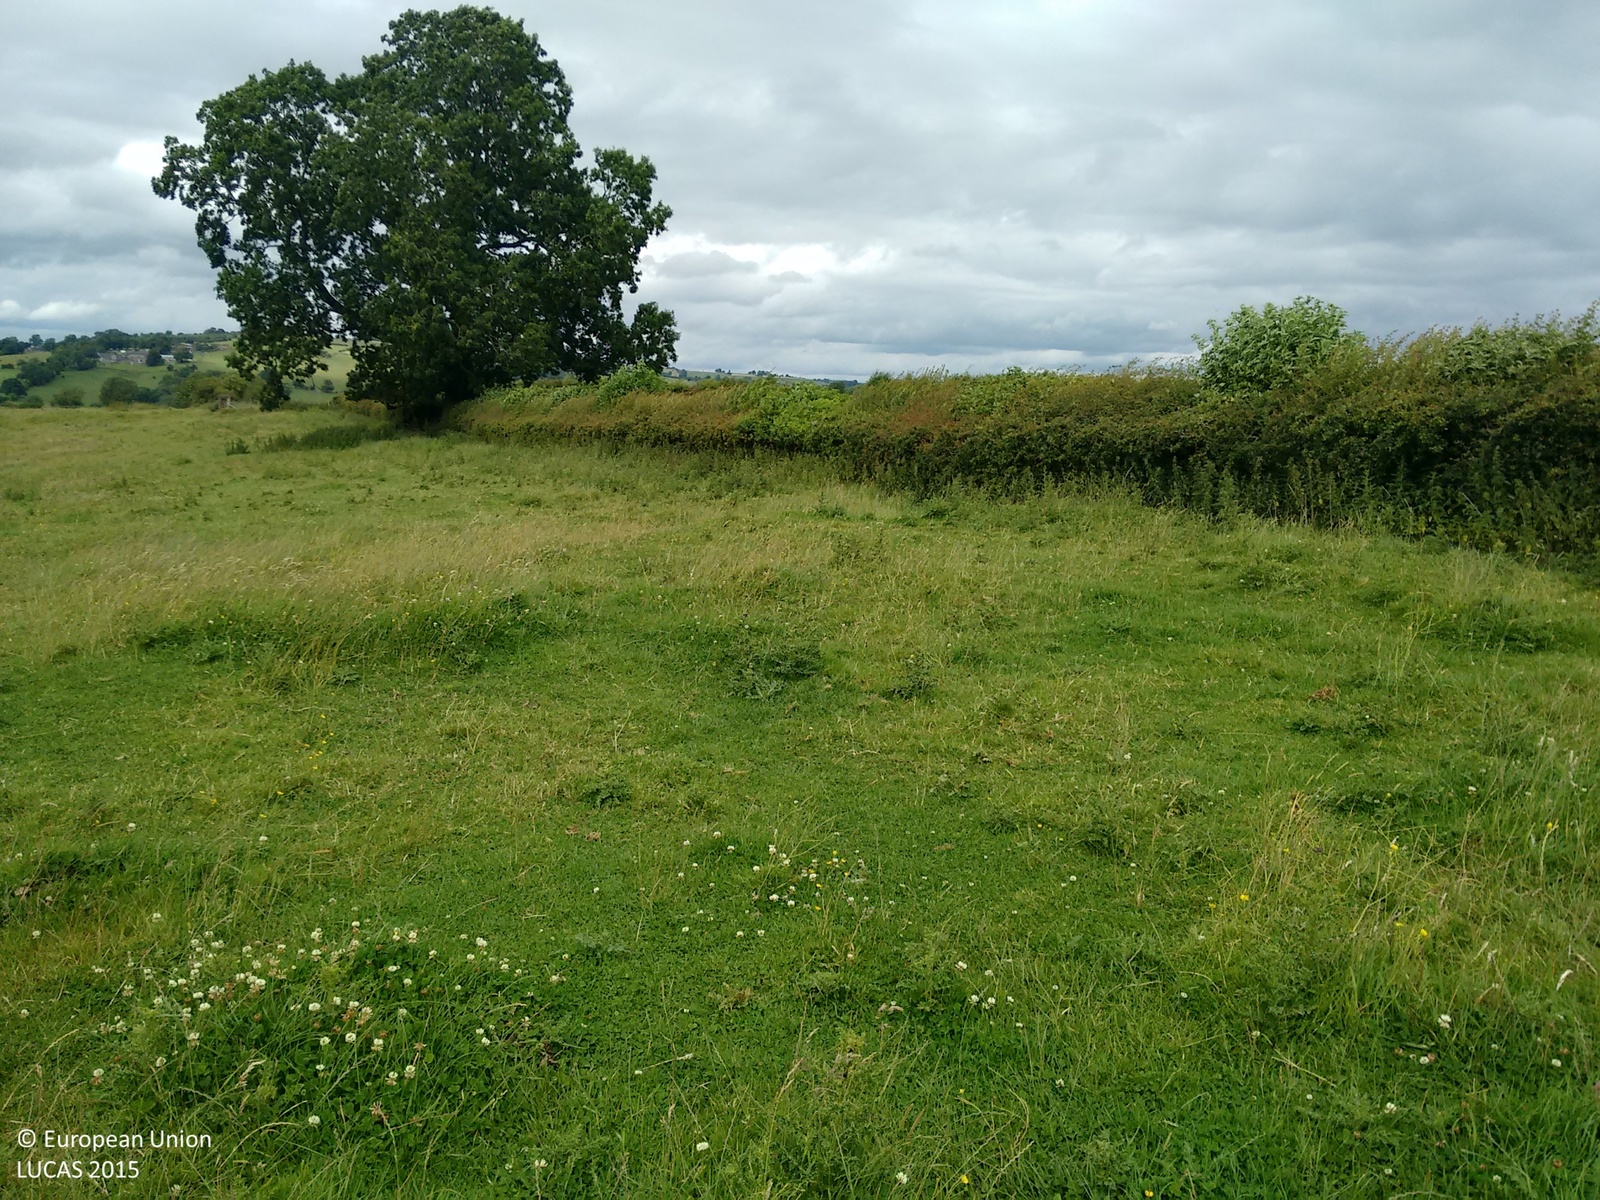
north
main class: Grassland
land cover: Grassland without tree/shrub cover
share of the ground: > 75 %
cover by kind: herbaceous plants 100 %
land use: Agriculture (excluding fallow land and kitchen gardens)
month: July
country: GB
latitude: 53.0176
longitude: -1.6652
